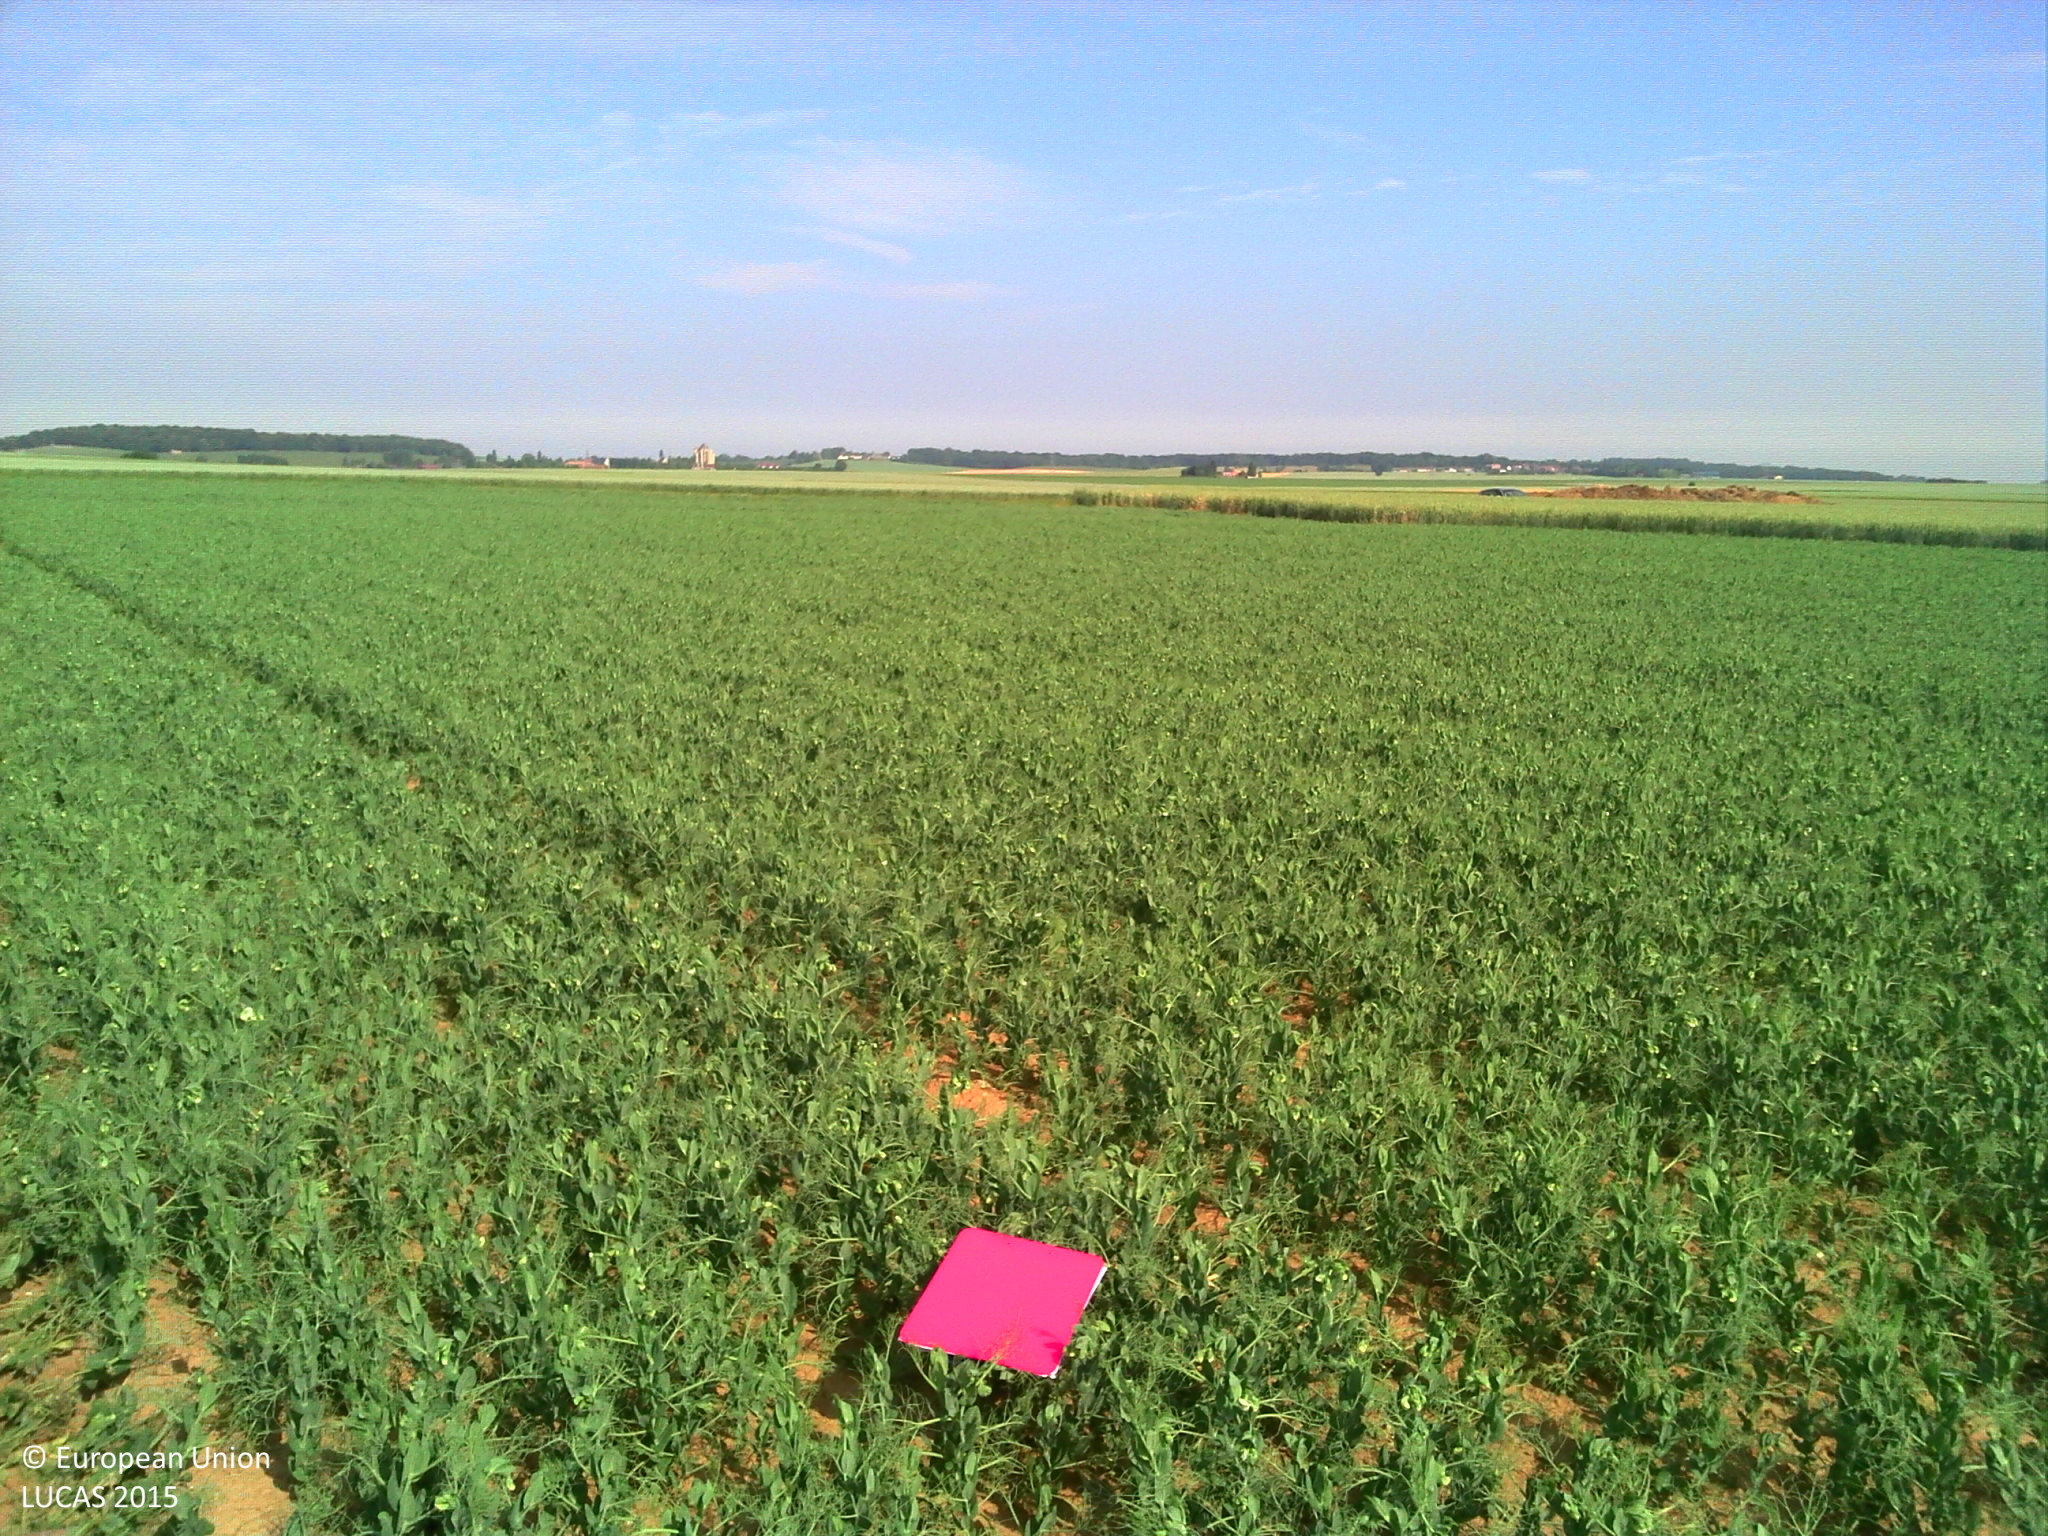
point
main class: Cropland
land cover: Dry pulses
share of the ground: > 75 %
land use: Agriculture (excluding fallow land and kitchen gardens)
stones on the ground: < 10 %
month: June
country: FR
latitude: 49.5102
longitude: 2.5997
